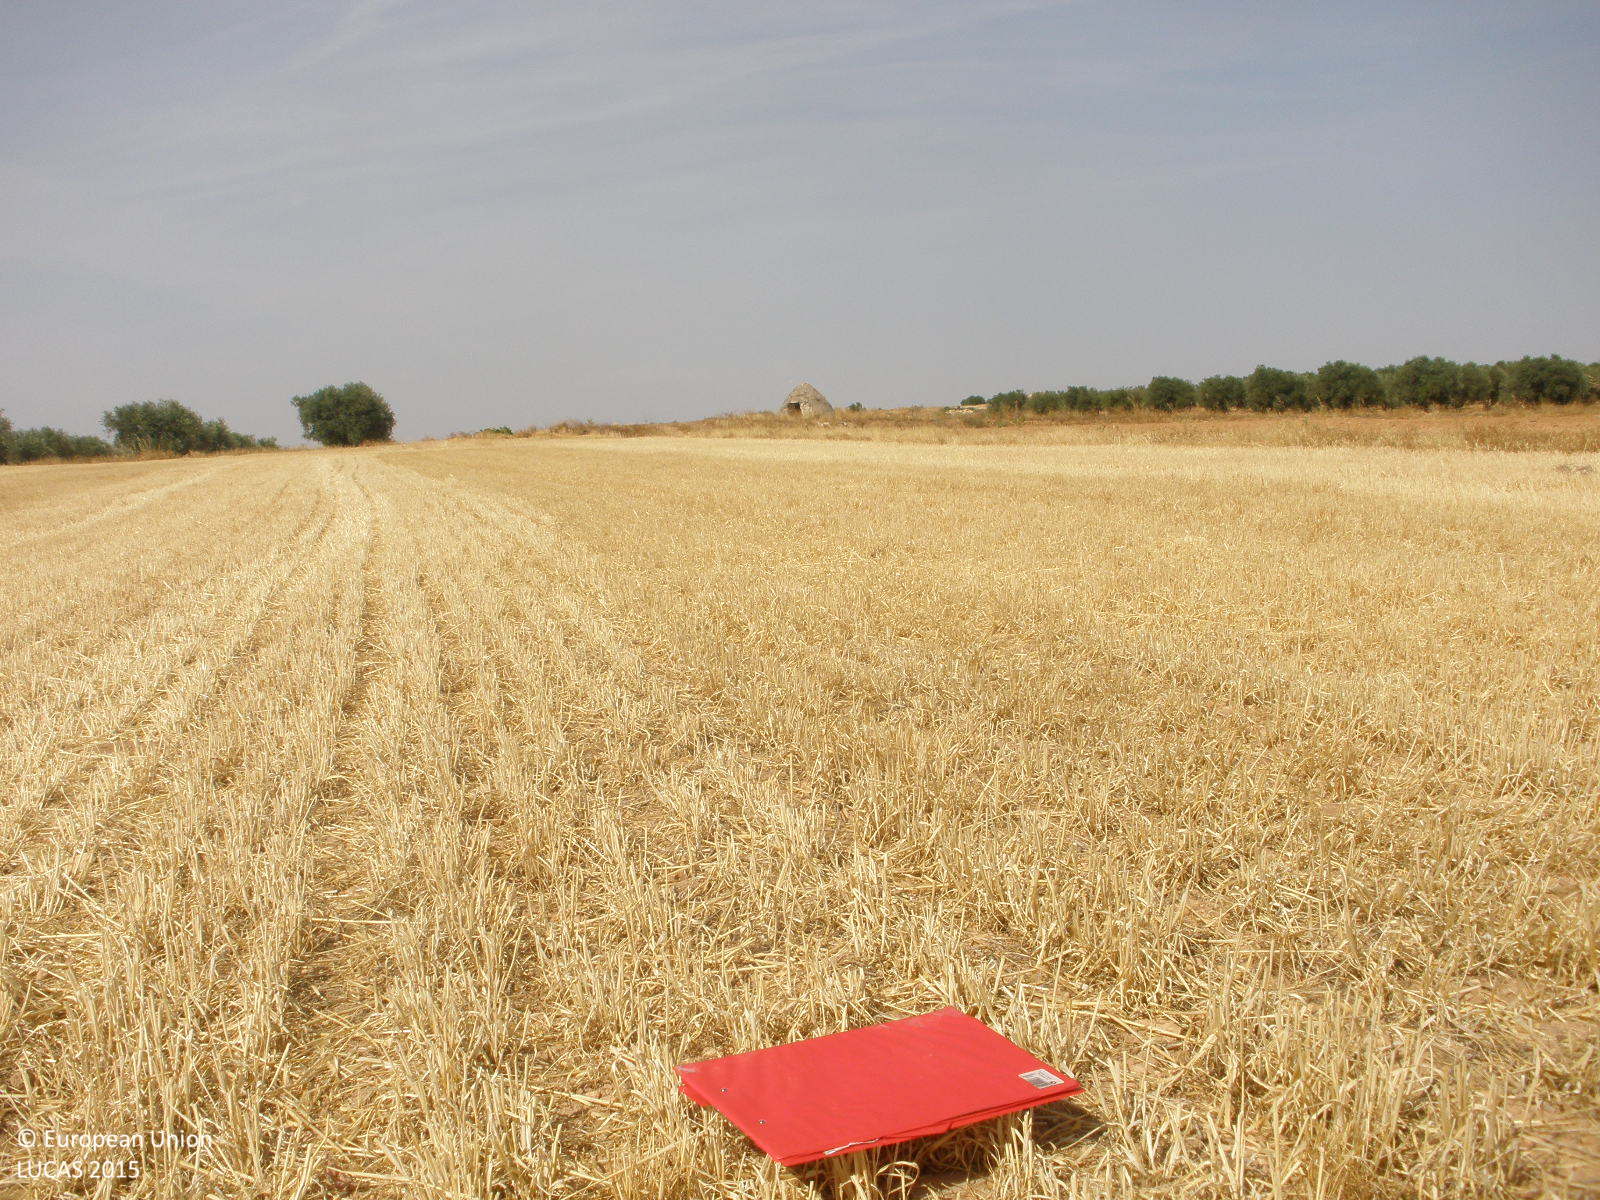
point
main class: Cropland
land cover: Barley
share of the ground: < 10 %
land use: Agriculture (excluding fallow land and kitchen gardens)
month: July
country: ES
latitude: 39.7367
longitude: -3.3379
